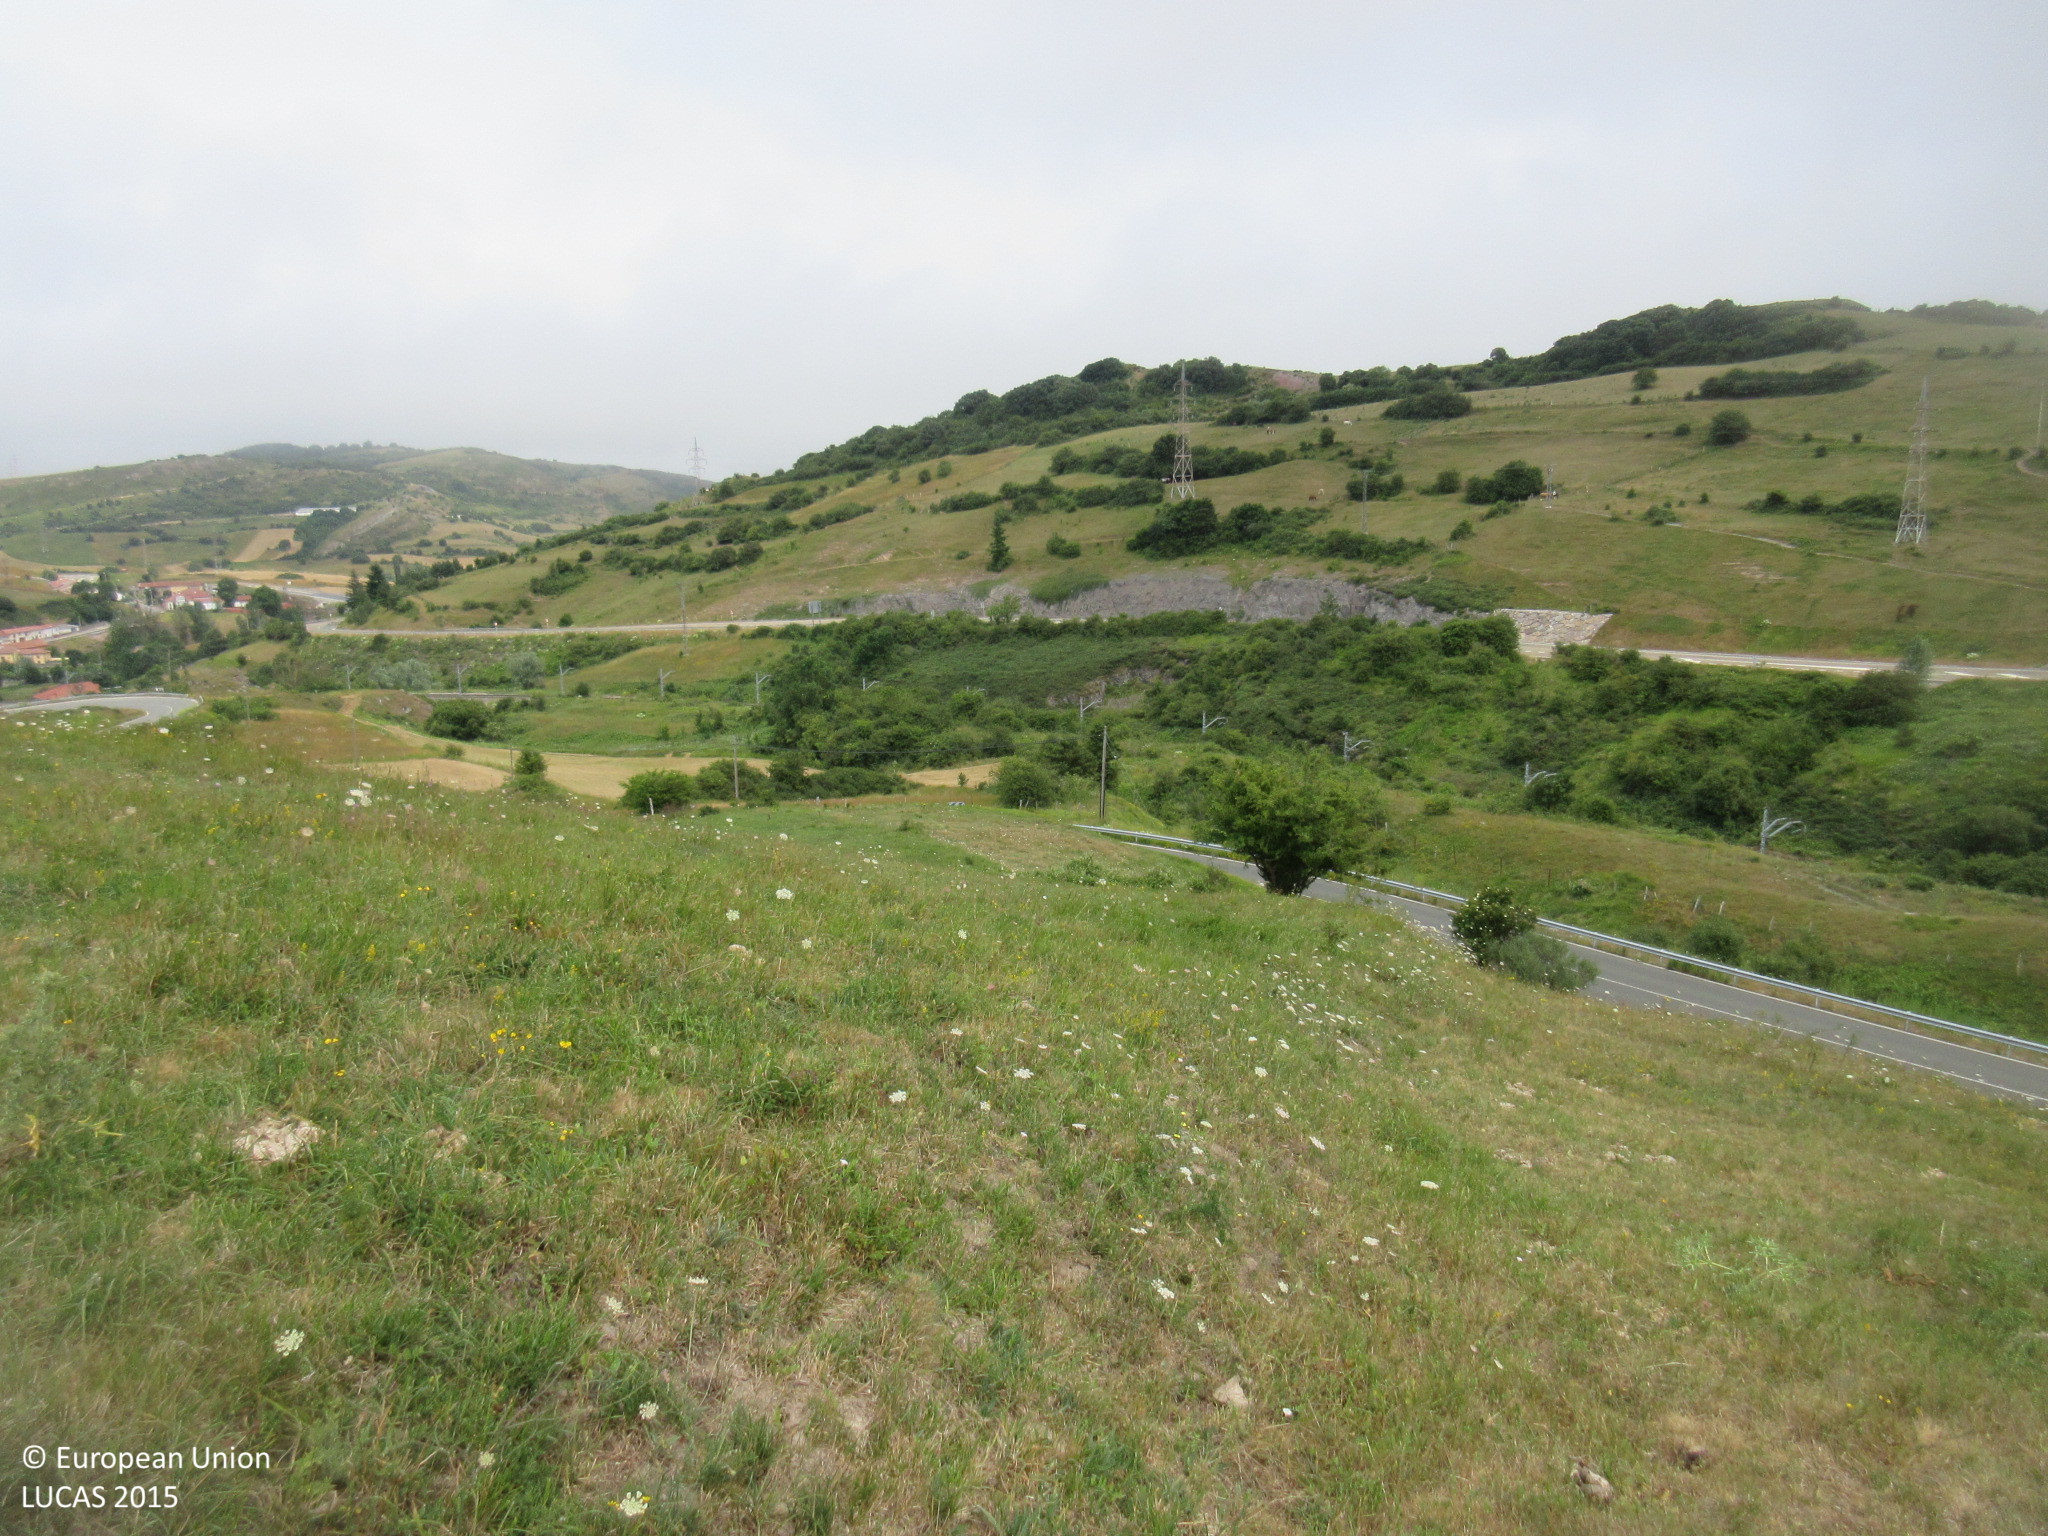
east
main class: Grassland
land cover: Grassland without tree/shrub cover
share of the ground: > 75 %
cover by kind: herbaceous plants 100 %
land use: Agriculture (excluding fallow land and kitchen gardens)
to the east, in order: Grassland without tree/shrub cover; Abandoned hedges; Grass margins; Paved roads, cycling and walking lanes; Shrubland with sparse tree cover; Fences; Grassland without tree/shrub cover; Tracks; Shrubland with sparse tree cover; Tracks; Shrubland with sparse tree cover; Railways; Broadleaved woodland; Grass margins; Paved roads, cycling and walking lanes
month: July
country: ES
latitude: 43.0131
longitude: -4.1230
